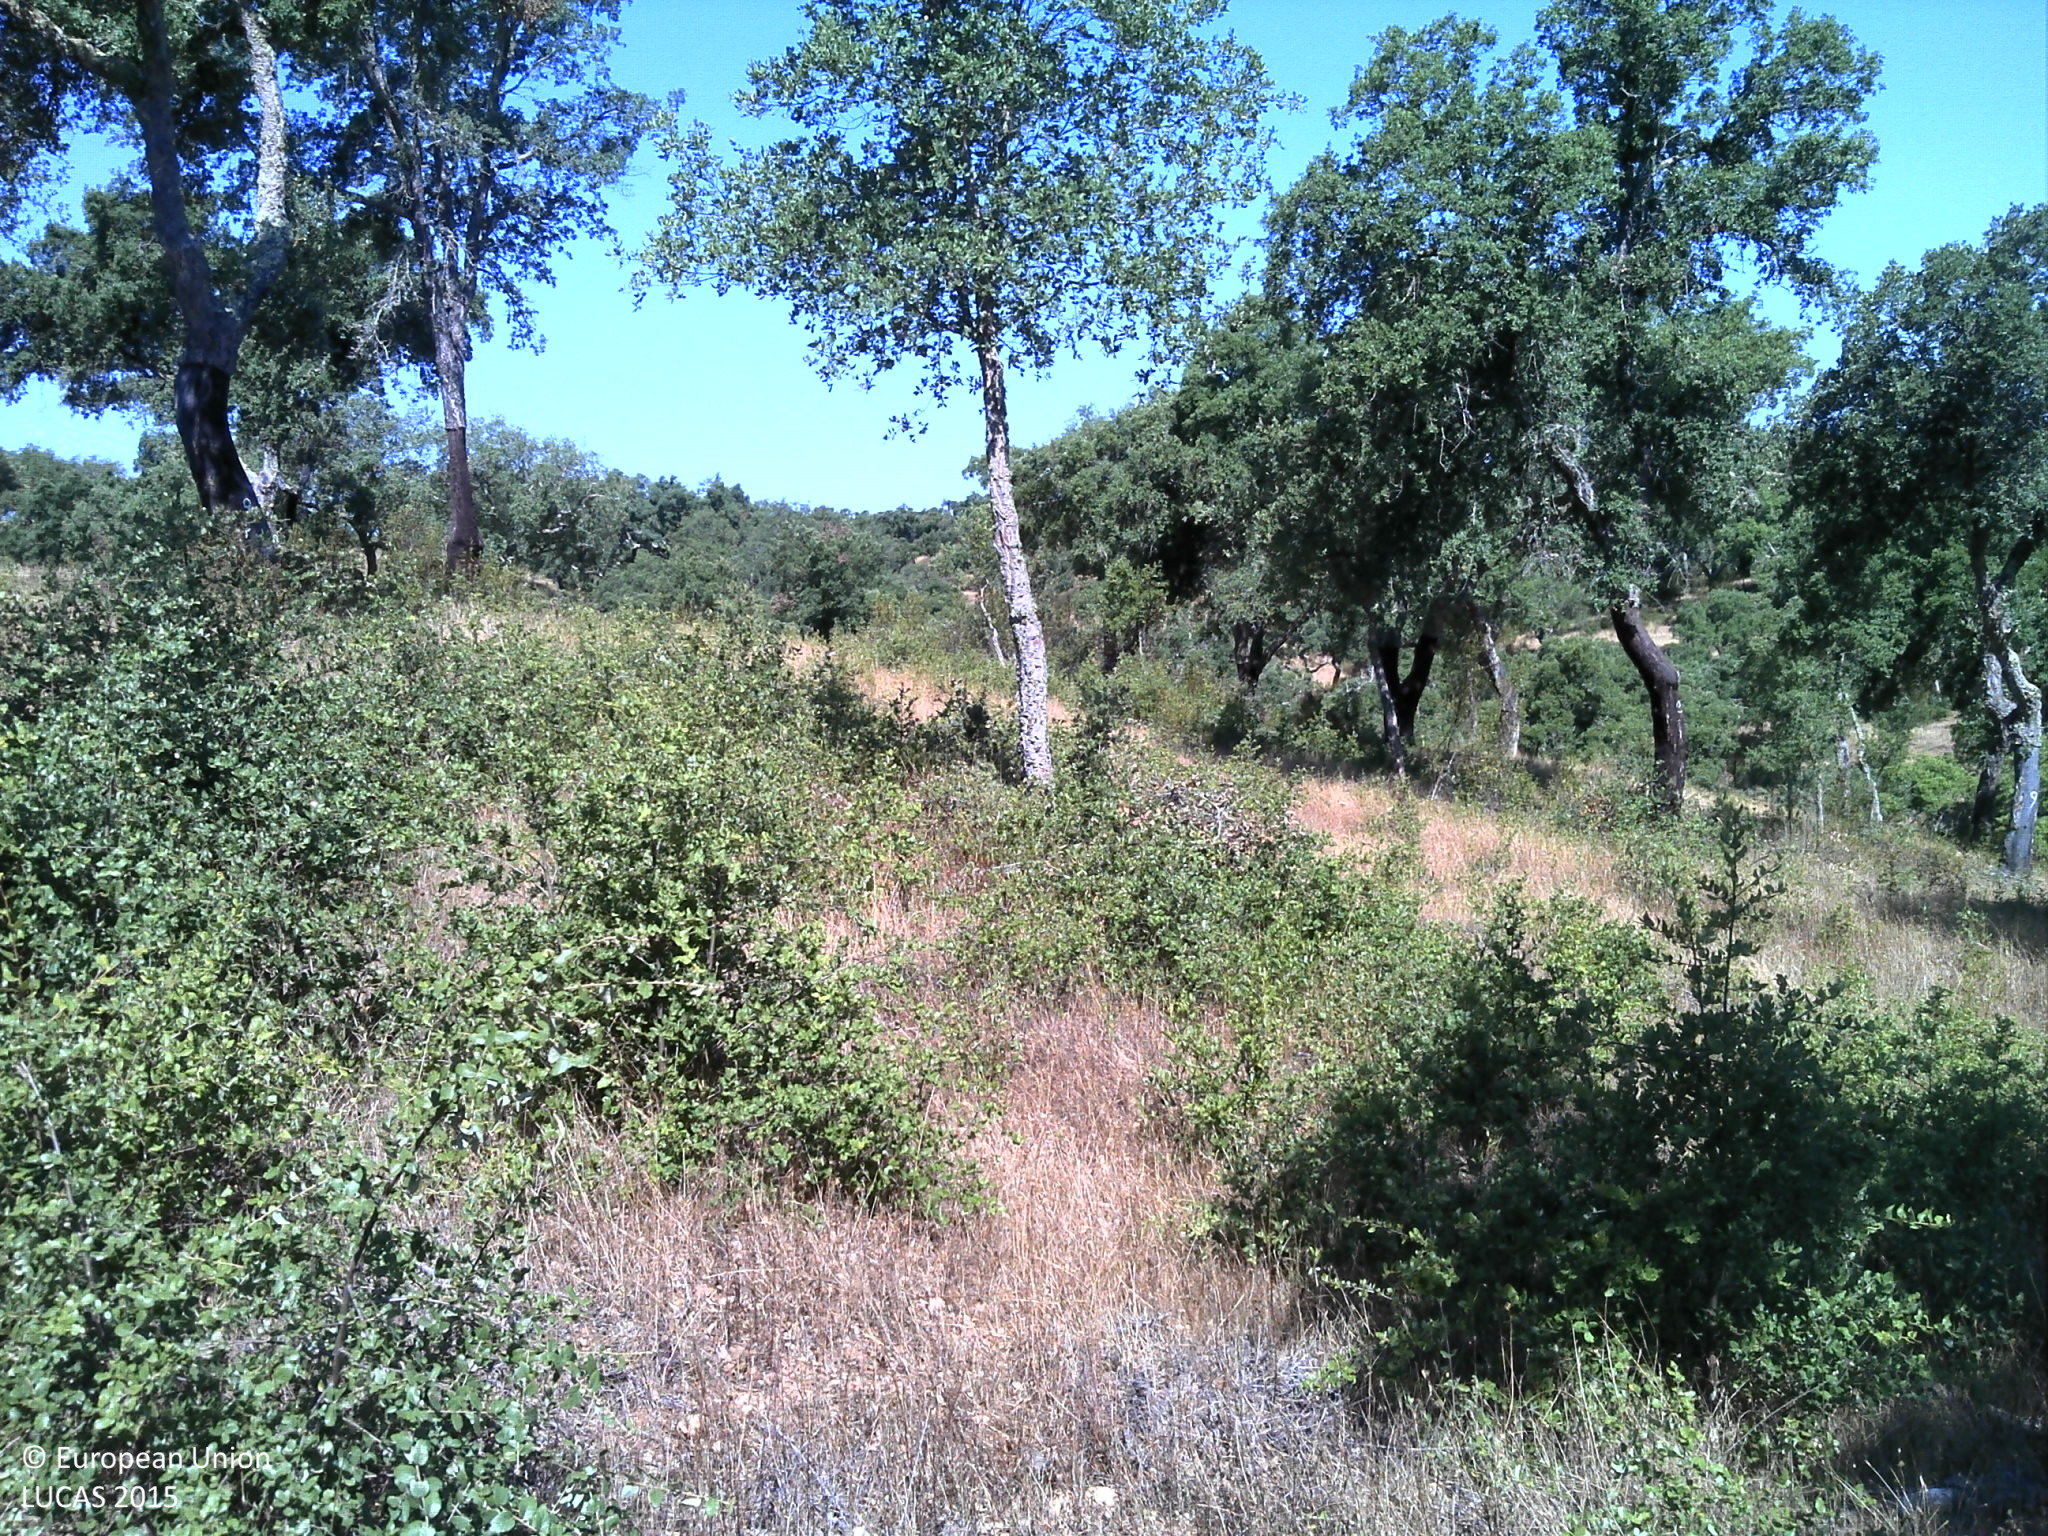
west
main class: Woodland
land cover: Broadleaved woodland
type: broadleaved evergreen forest
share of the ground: 25 - 50 %
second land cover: Grassland without tree/shrub cover
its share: 25 - 50 %
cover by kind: broadleaved forest trees 40 %, herbaceous plants 40 %, consolidated bare surface 20 %
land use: Forestry
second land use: Agriculture (excluding fallow land and kitchen gardens)
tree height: > 5 m
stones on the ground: < 10 %
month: June
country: PT
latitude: 37.8019
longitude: -8.5179
